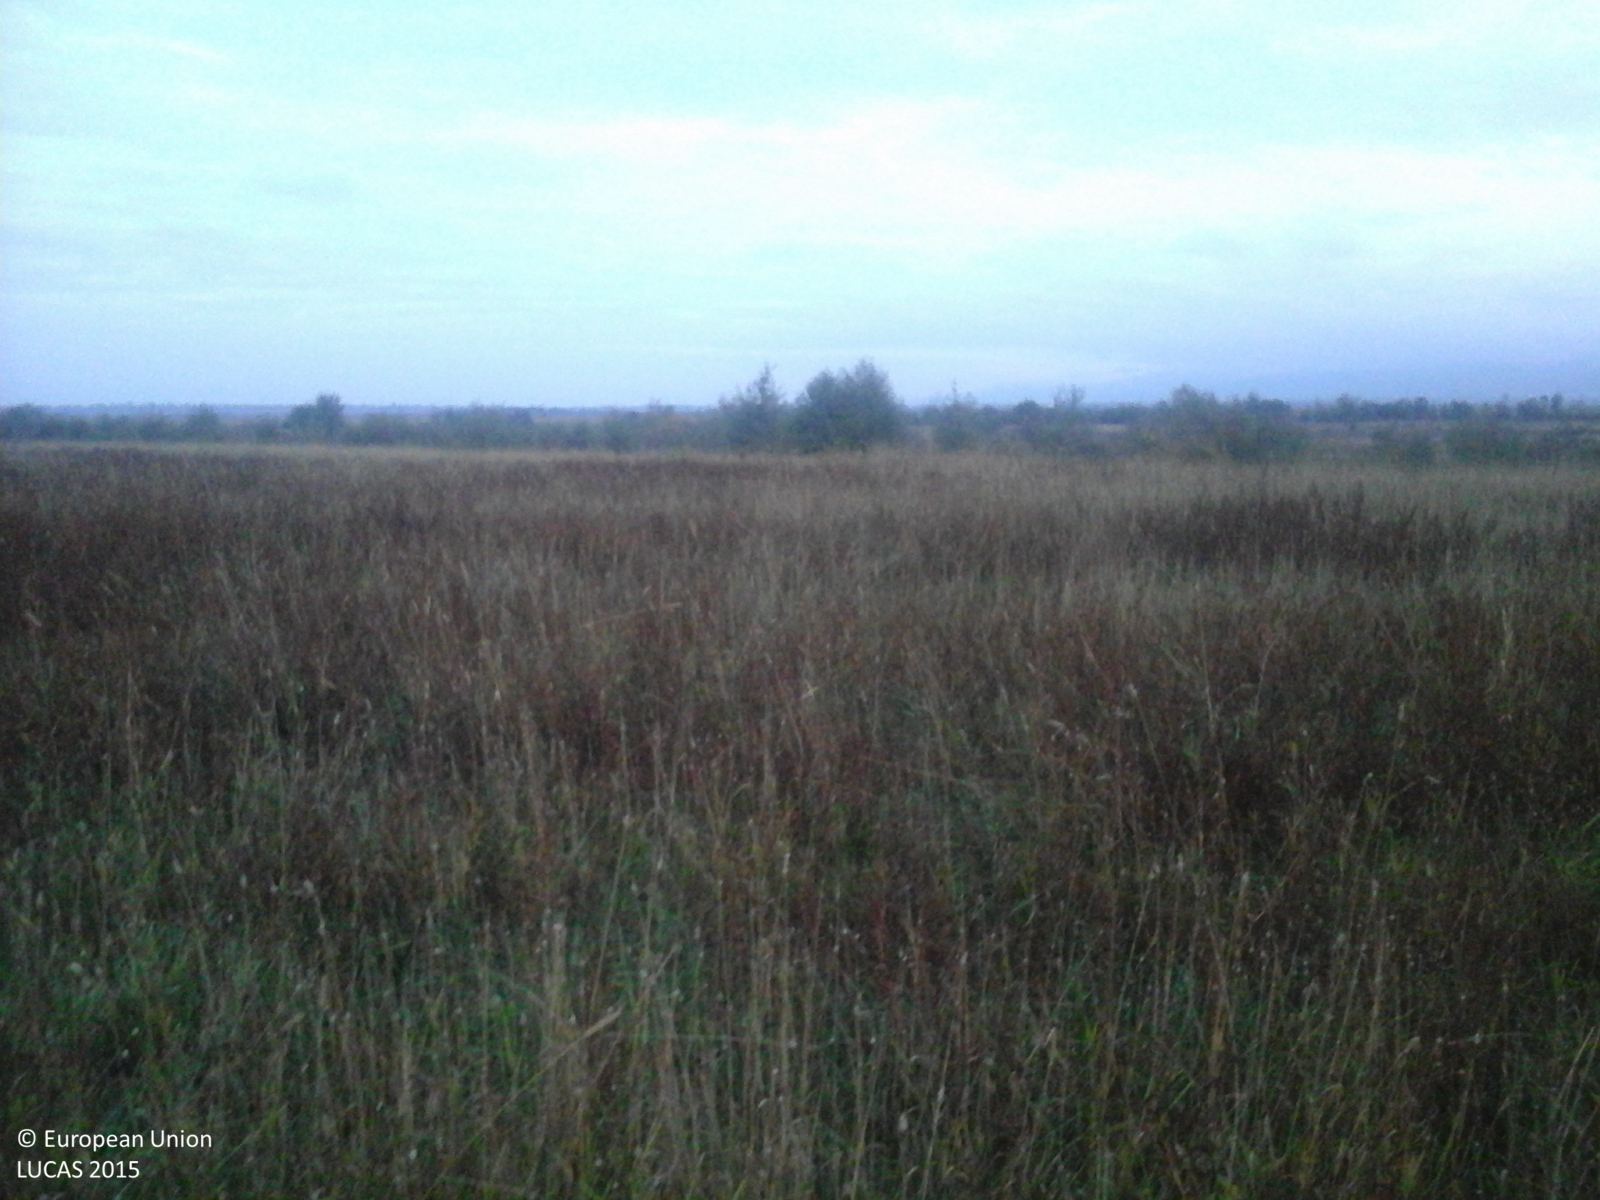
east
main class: Grassland
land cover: Grassland without tree/shrub cover
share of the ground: > 75 %
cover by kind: herbaceous plants 100 %
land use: Agriculture (excluding fallow land and kitchen gardens)
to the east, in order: Grassland without tree/shrub cover; Tracks; Grassland with sparse tree/shrub cover; Abandoned hedges; Rivers and streams; Abandoned hedges; Grassland with sparse tree/shrub cover; Ditches and canals; Abandoned hedges; Spontaneously vegetated surfaces
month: October
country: RO
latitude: 45.7352
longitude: 24.8022
